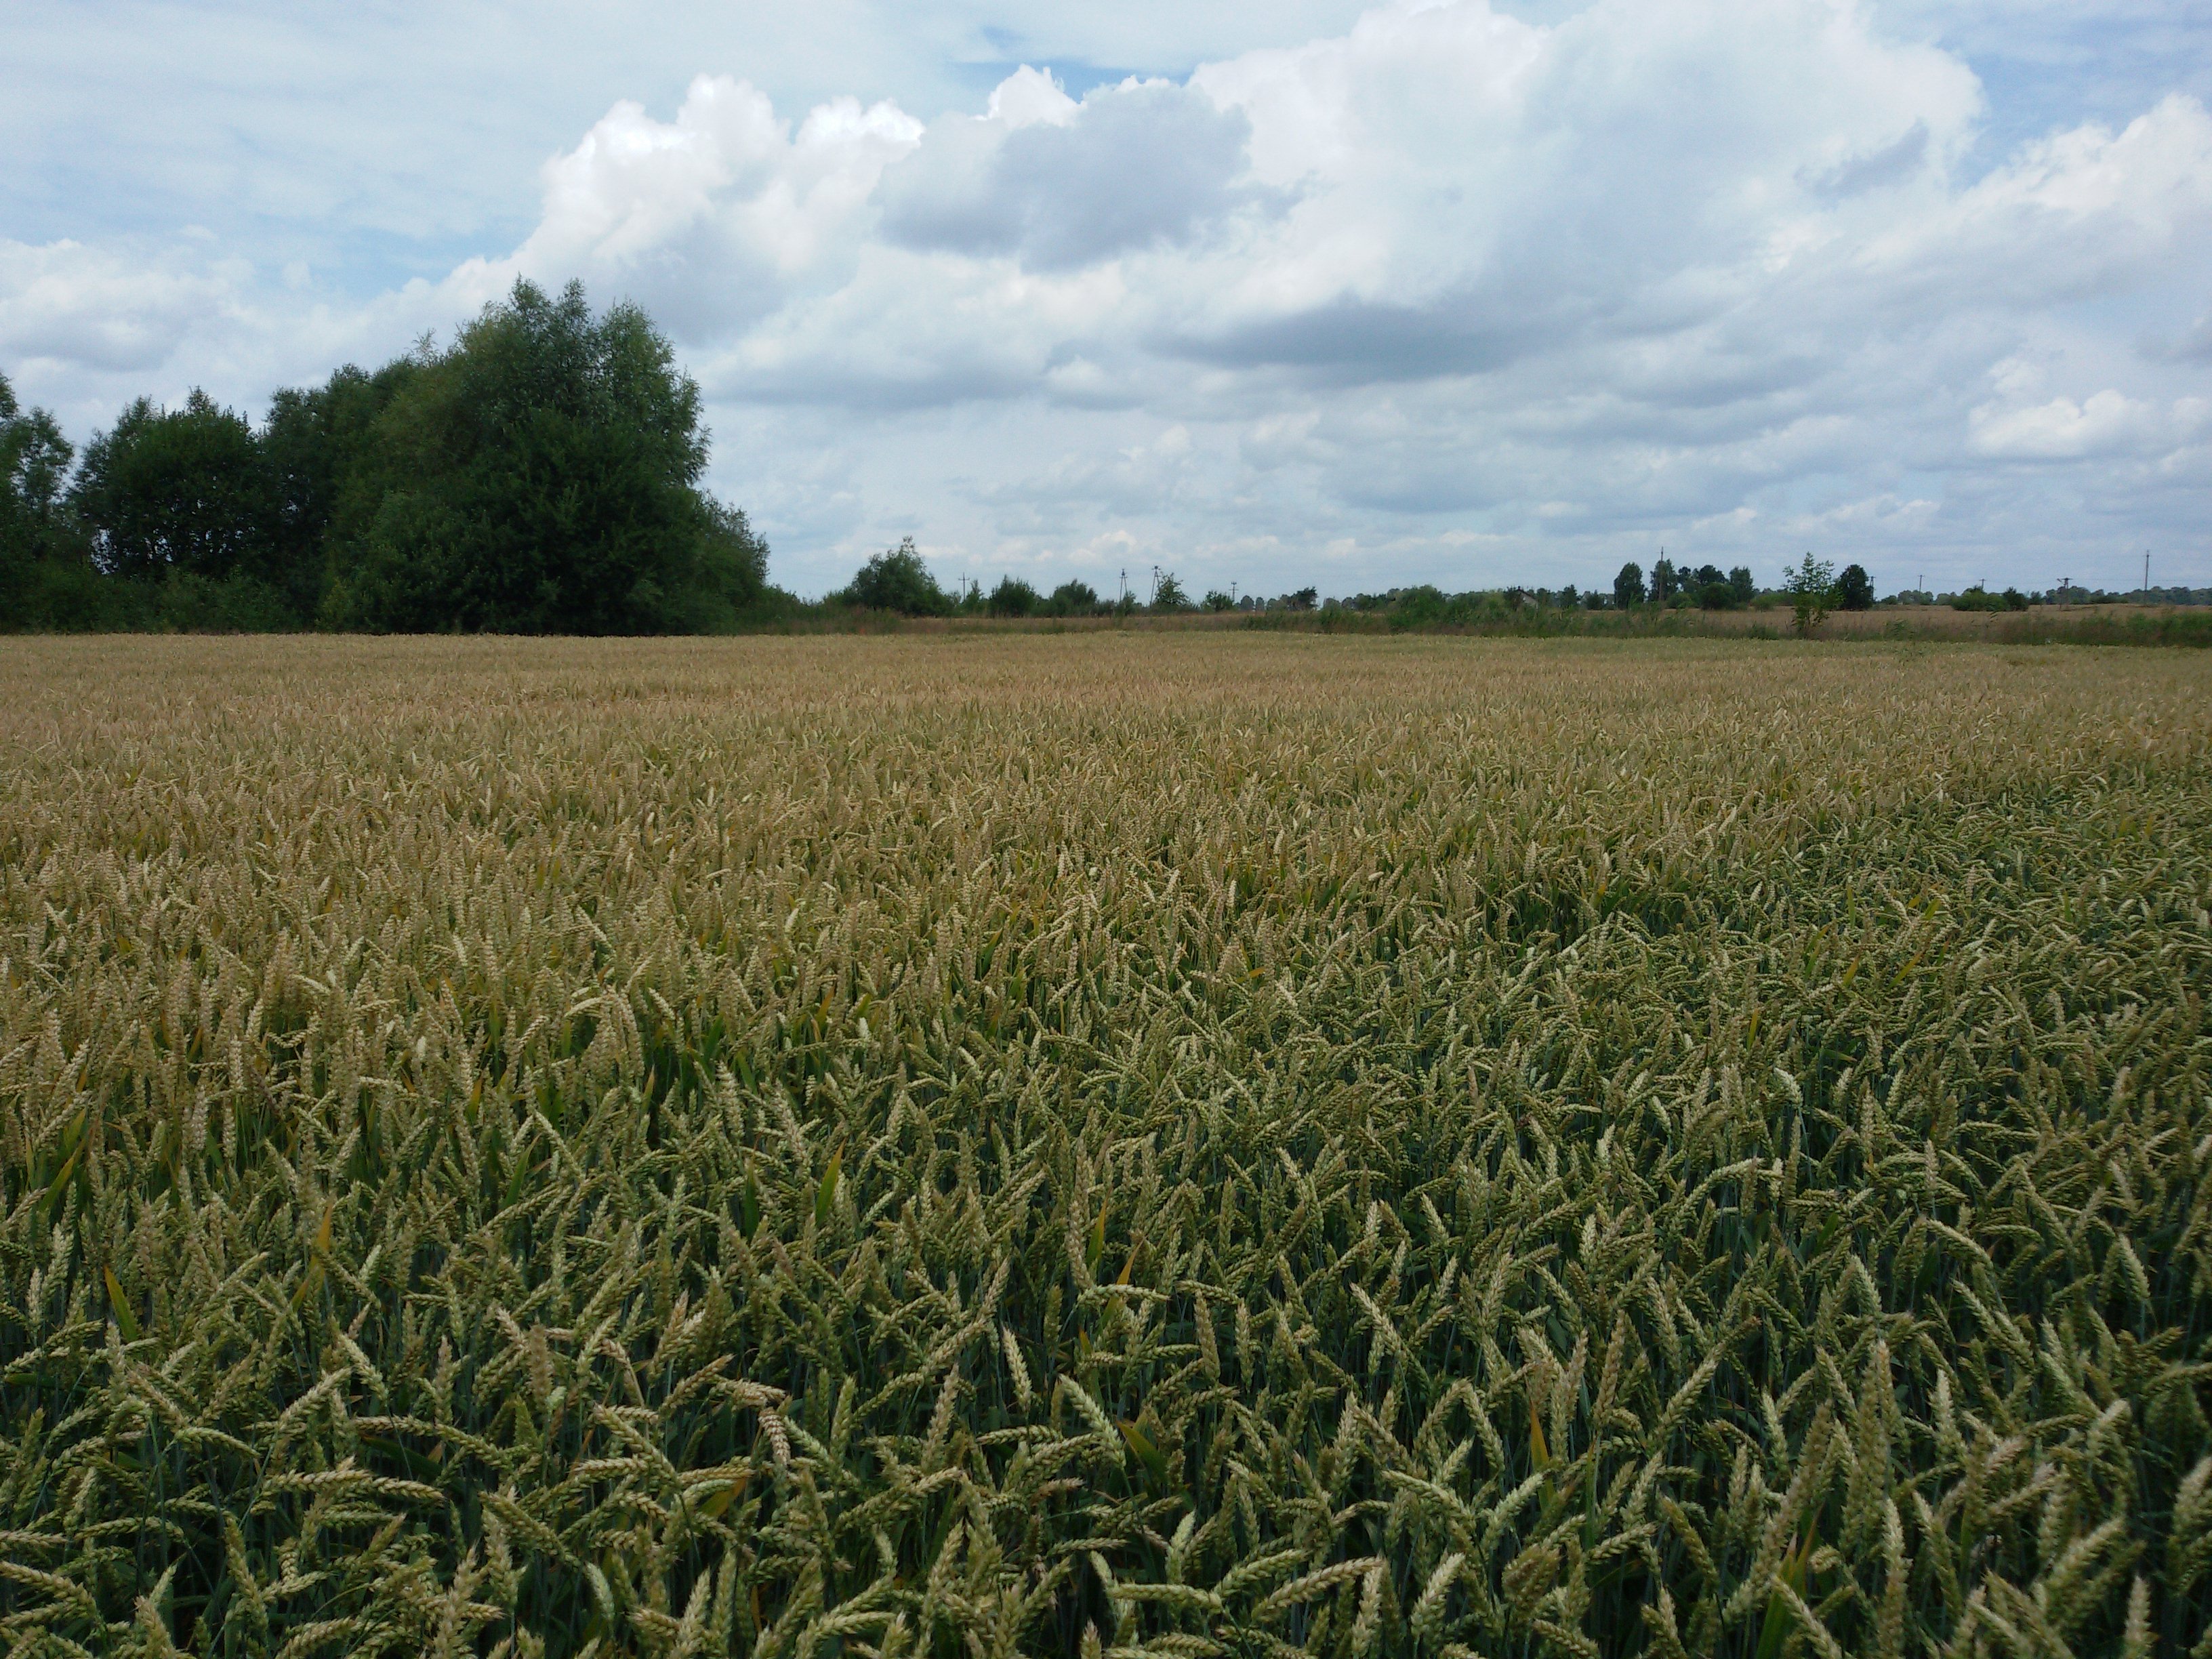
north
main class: Cropland
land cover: Common wheat
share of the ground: > 75 %
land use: Agriculture (excluding fallow land and kitchen gardens)
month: July
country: PL
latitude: 51.7292
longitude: 22.8570
